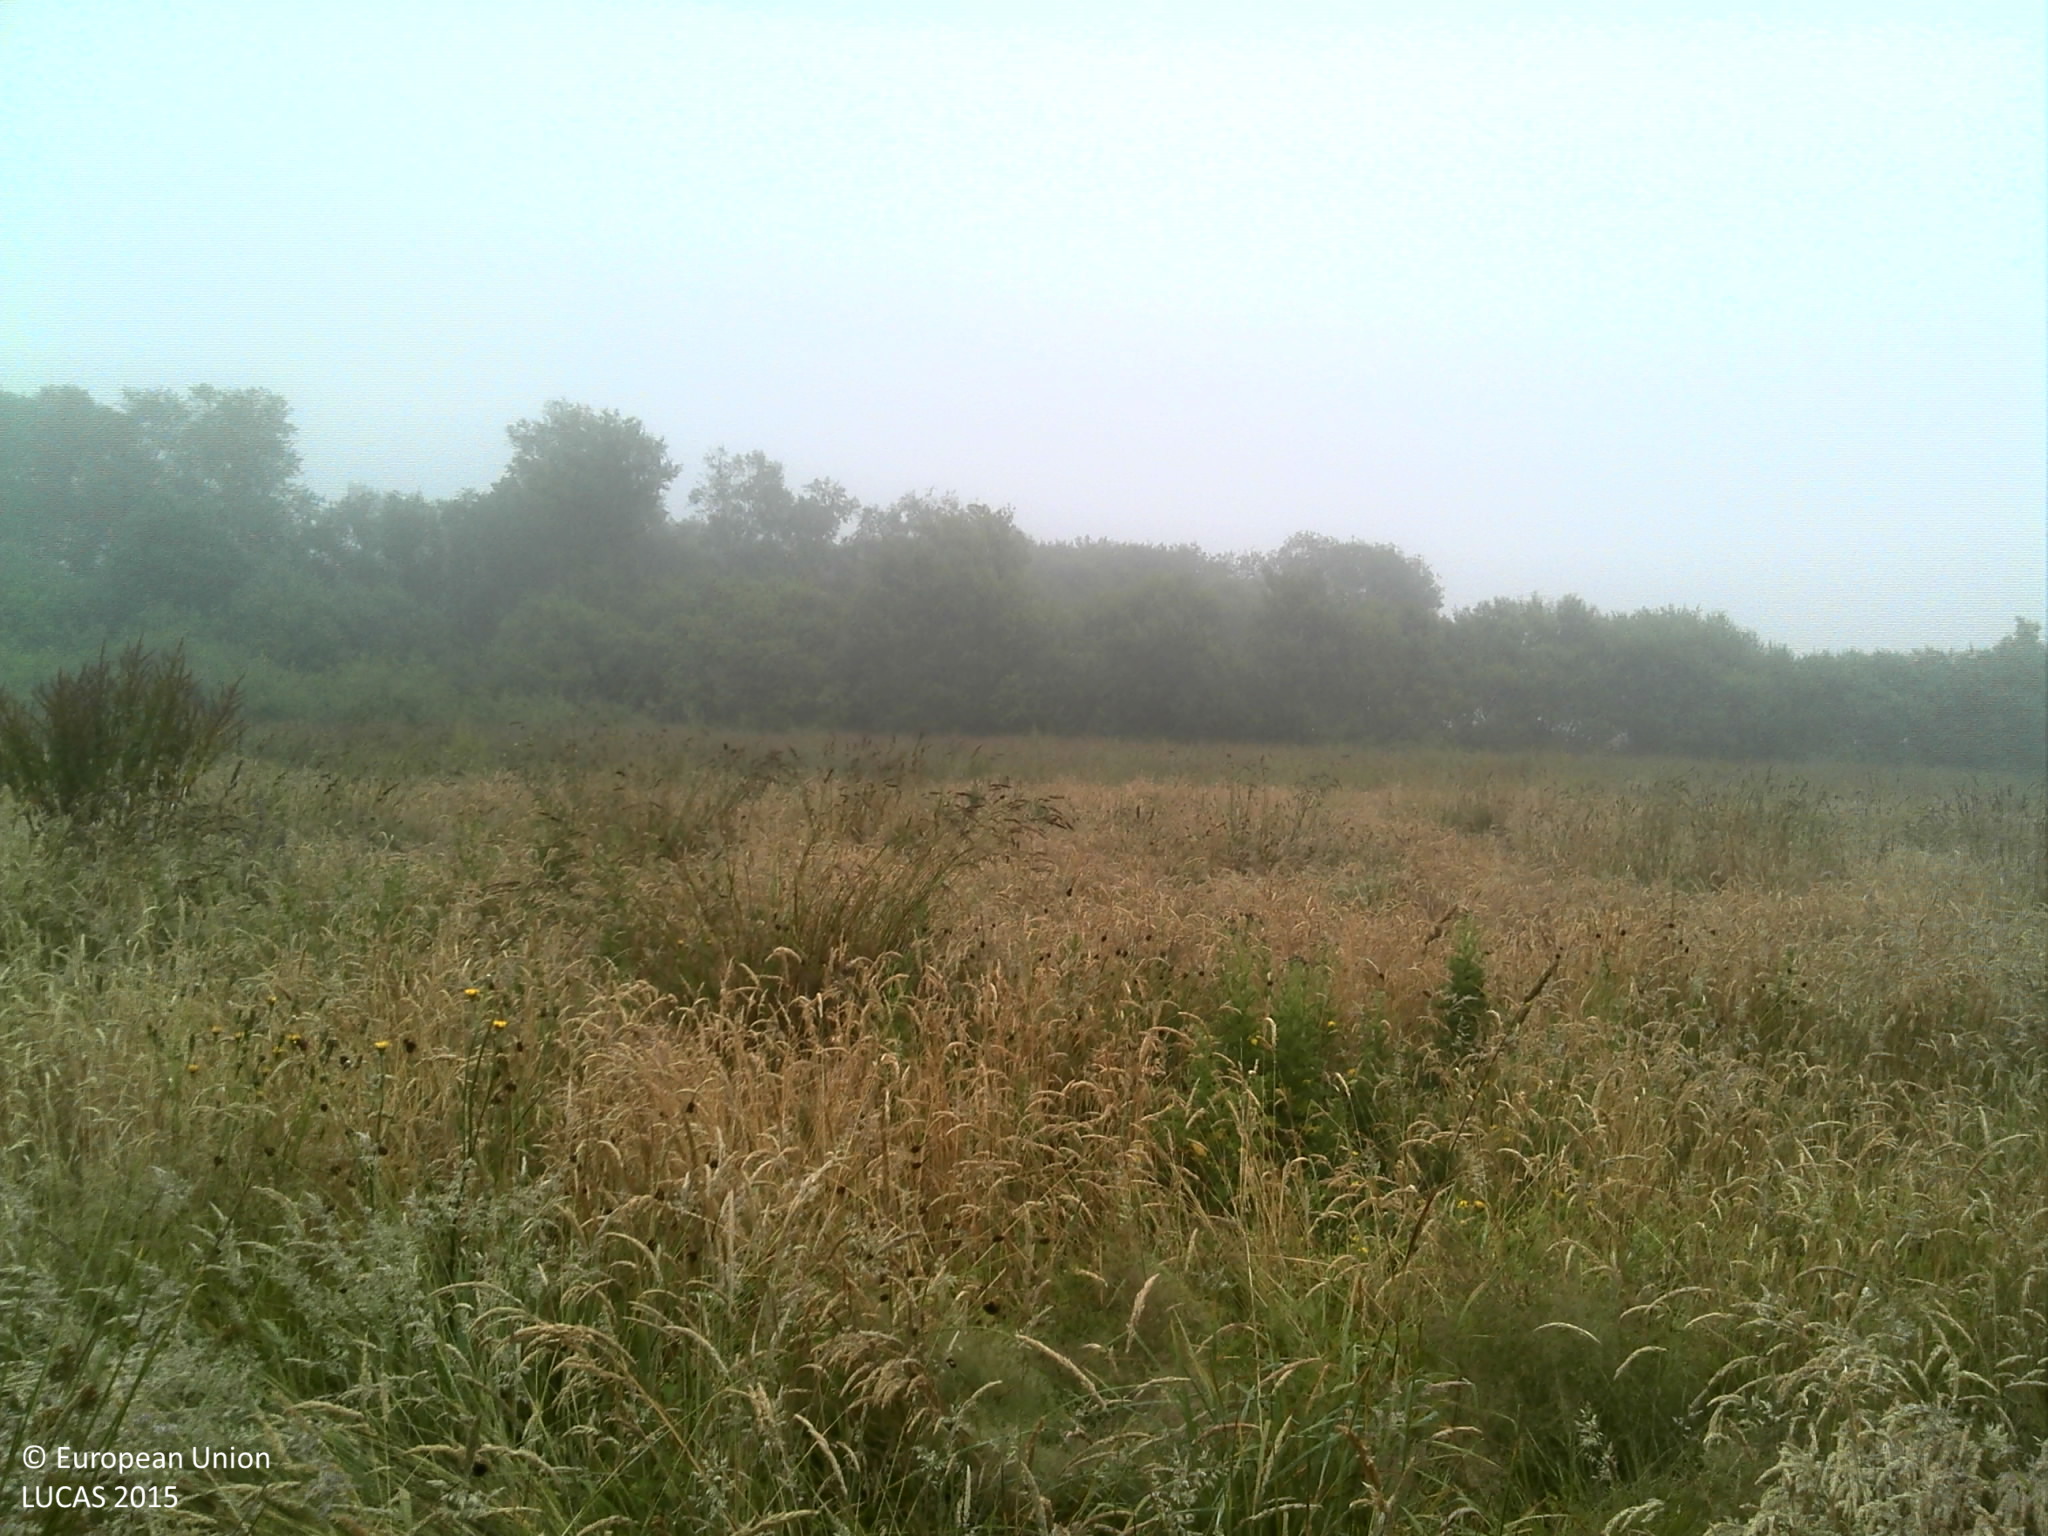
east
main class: Grassland
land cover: Grassland without tree/shrub cover
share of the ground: > 75 %
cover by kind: herbaceous plants 100 %
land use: Agriculture (excluding fallow land and kitchen gardens)
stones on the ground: < 10 %
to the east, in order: Grassland without tree/shrub cover; Broadleaved woodland; Ditches and canals; Tracks; Broadleaved woodland; Rape and turnip rape; Managed hedges; Rape and turnip rape
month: July
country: FR
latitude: 48.2073
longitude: -4.2348
